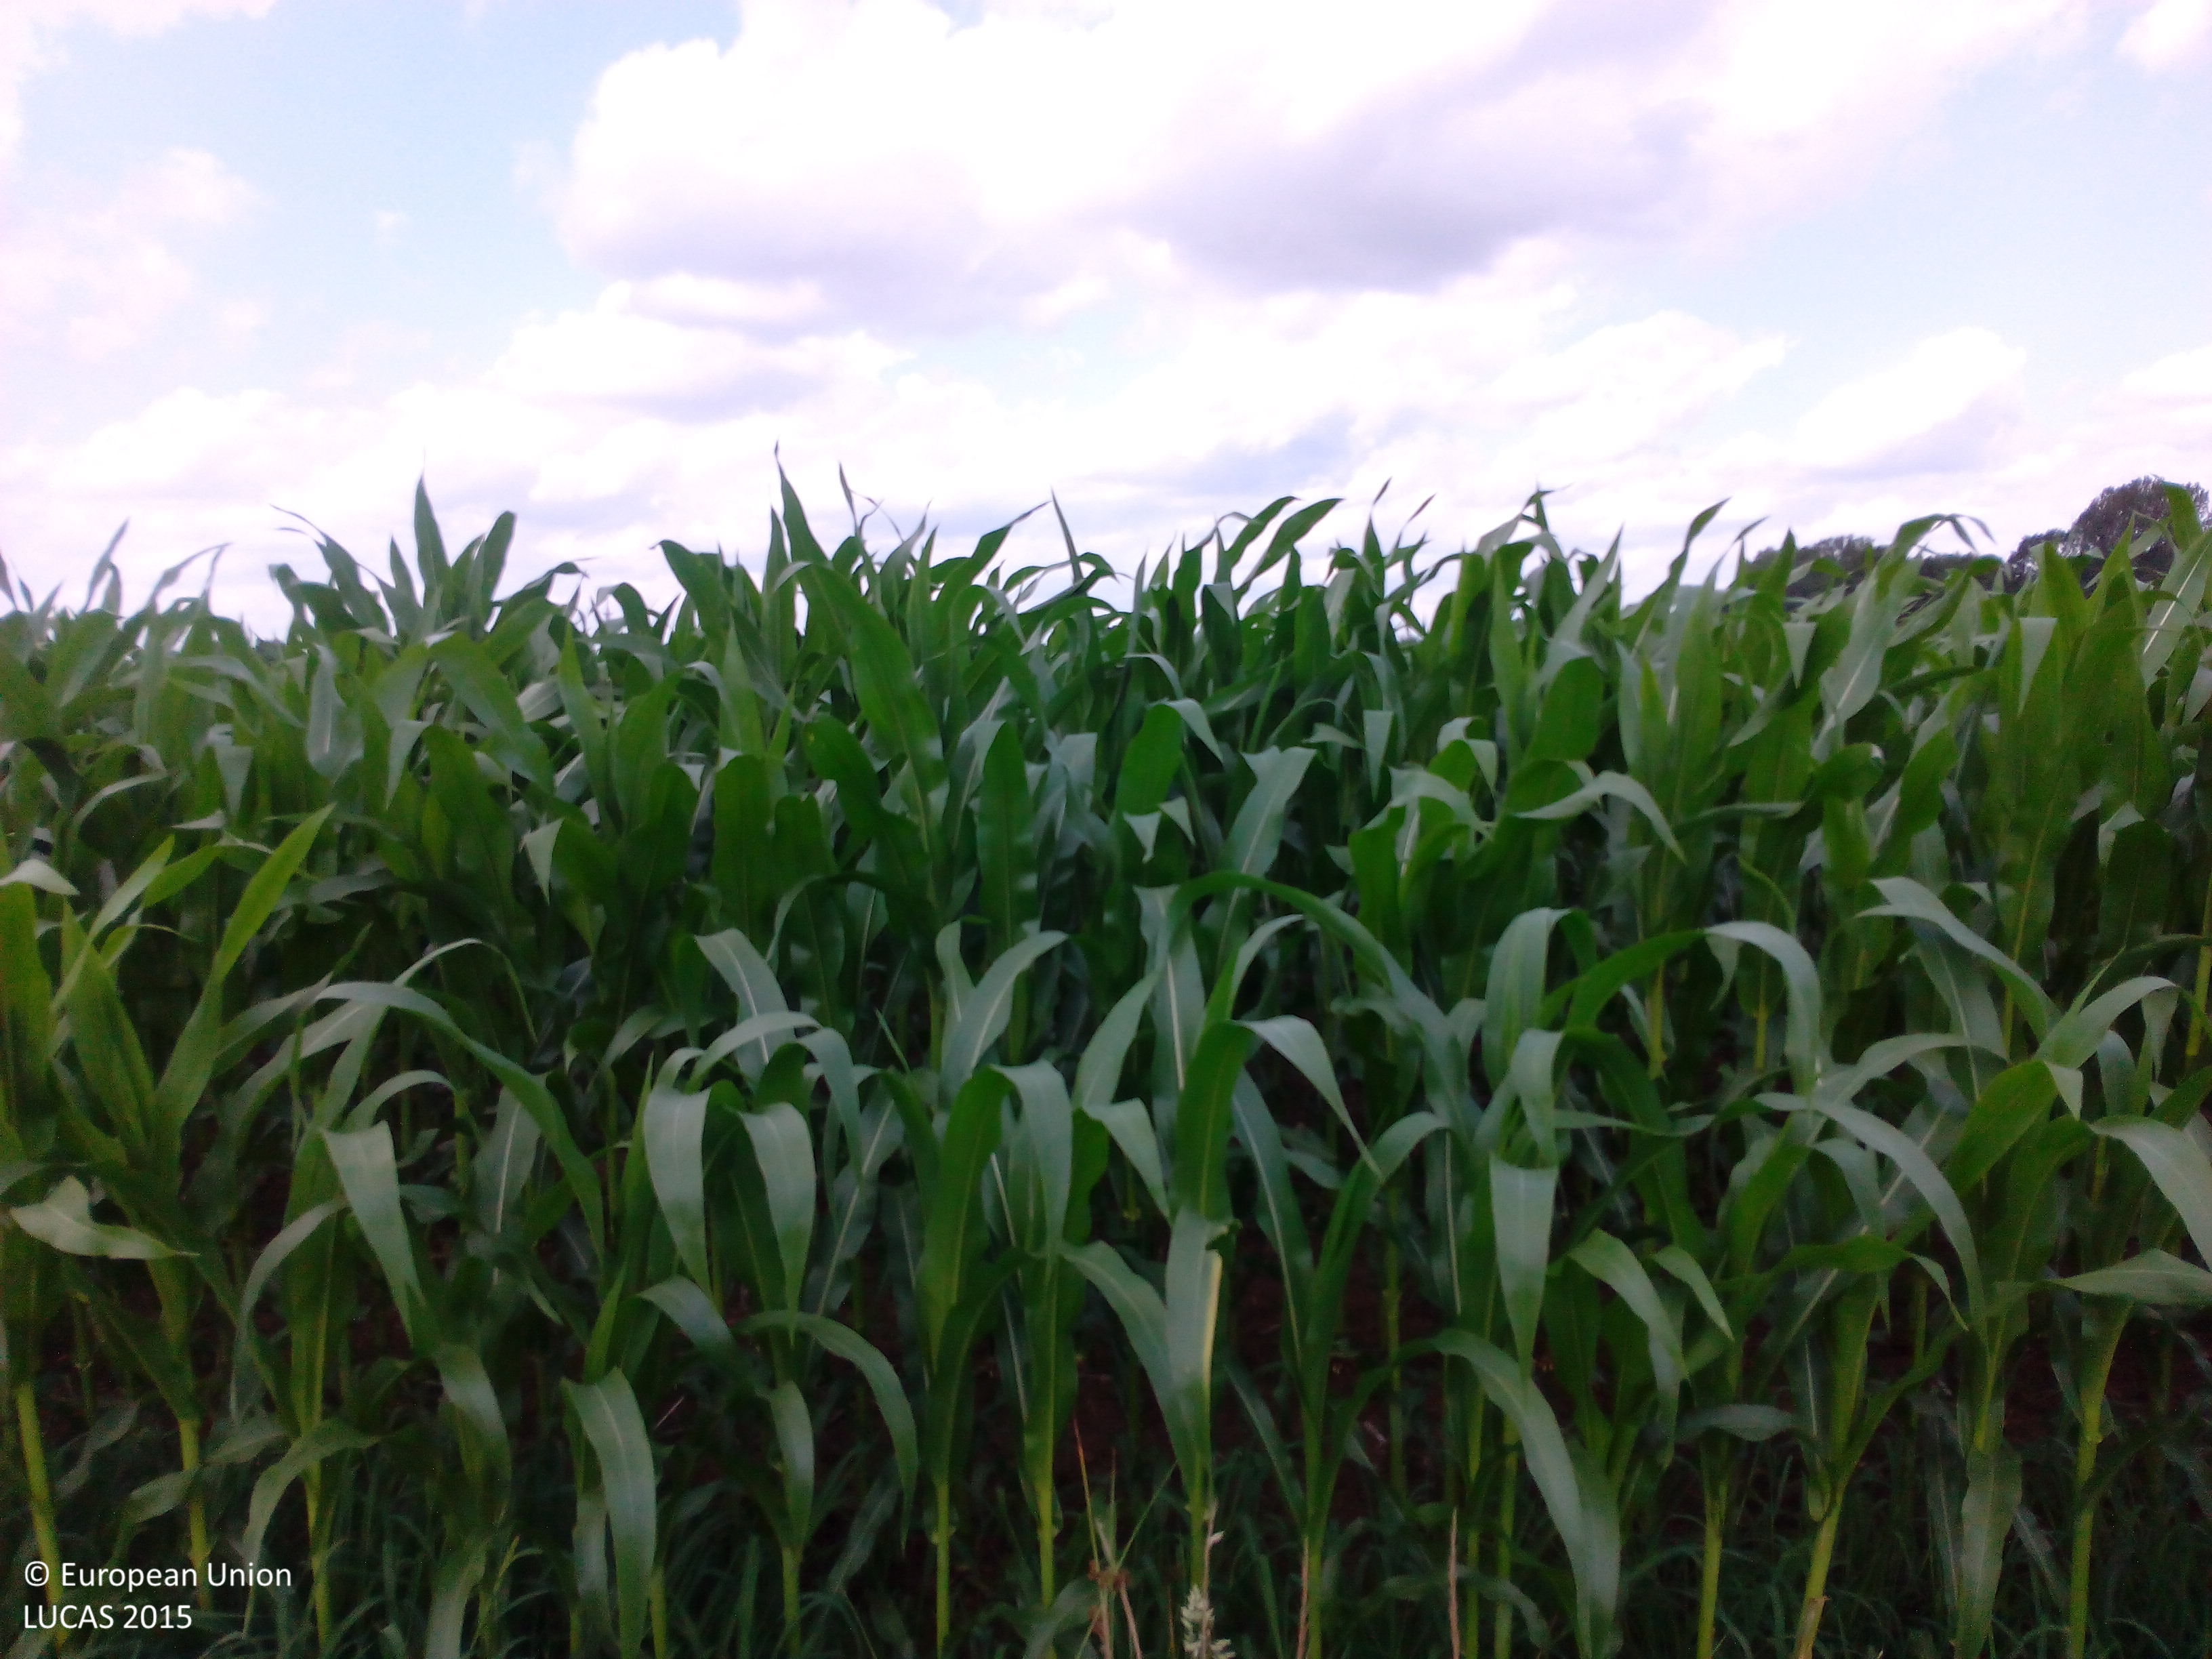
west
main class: Cropland
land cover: Maize
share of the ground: > 75 %
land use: Agriculture (excluding fallow land and kitchen gardens)
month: July
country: DE
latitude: 52.6659
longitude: 7.9748
